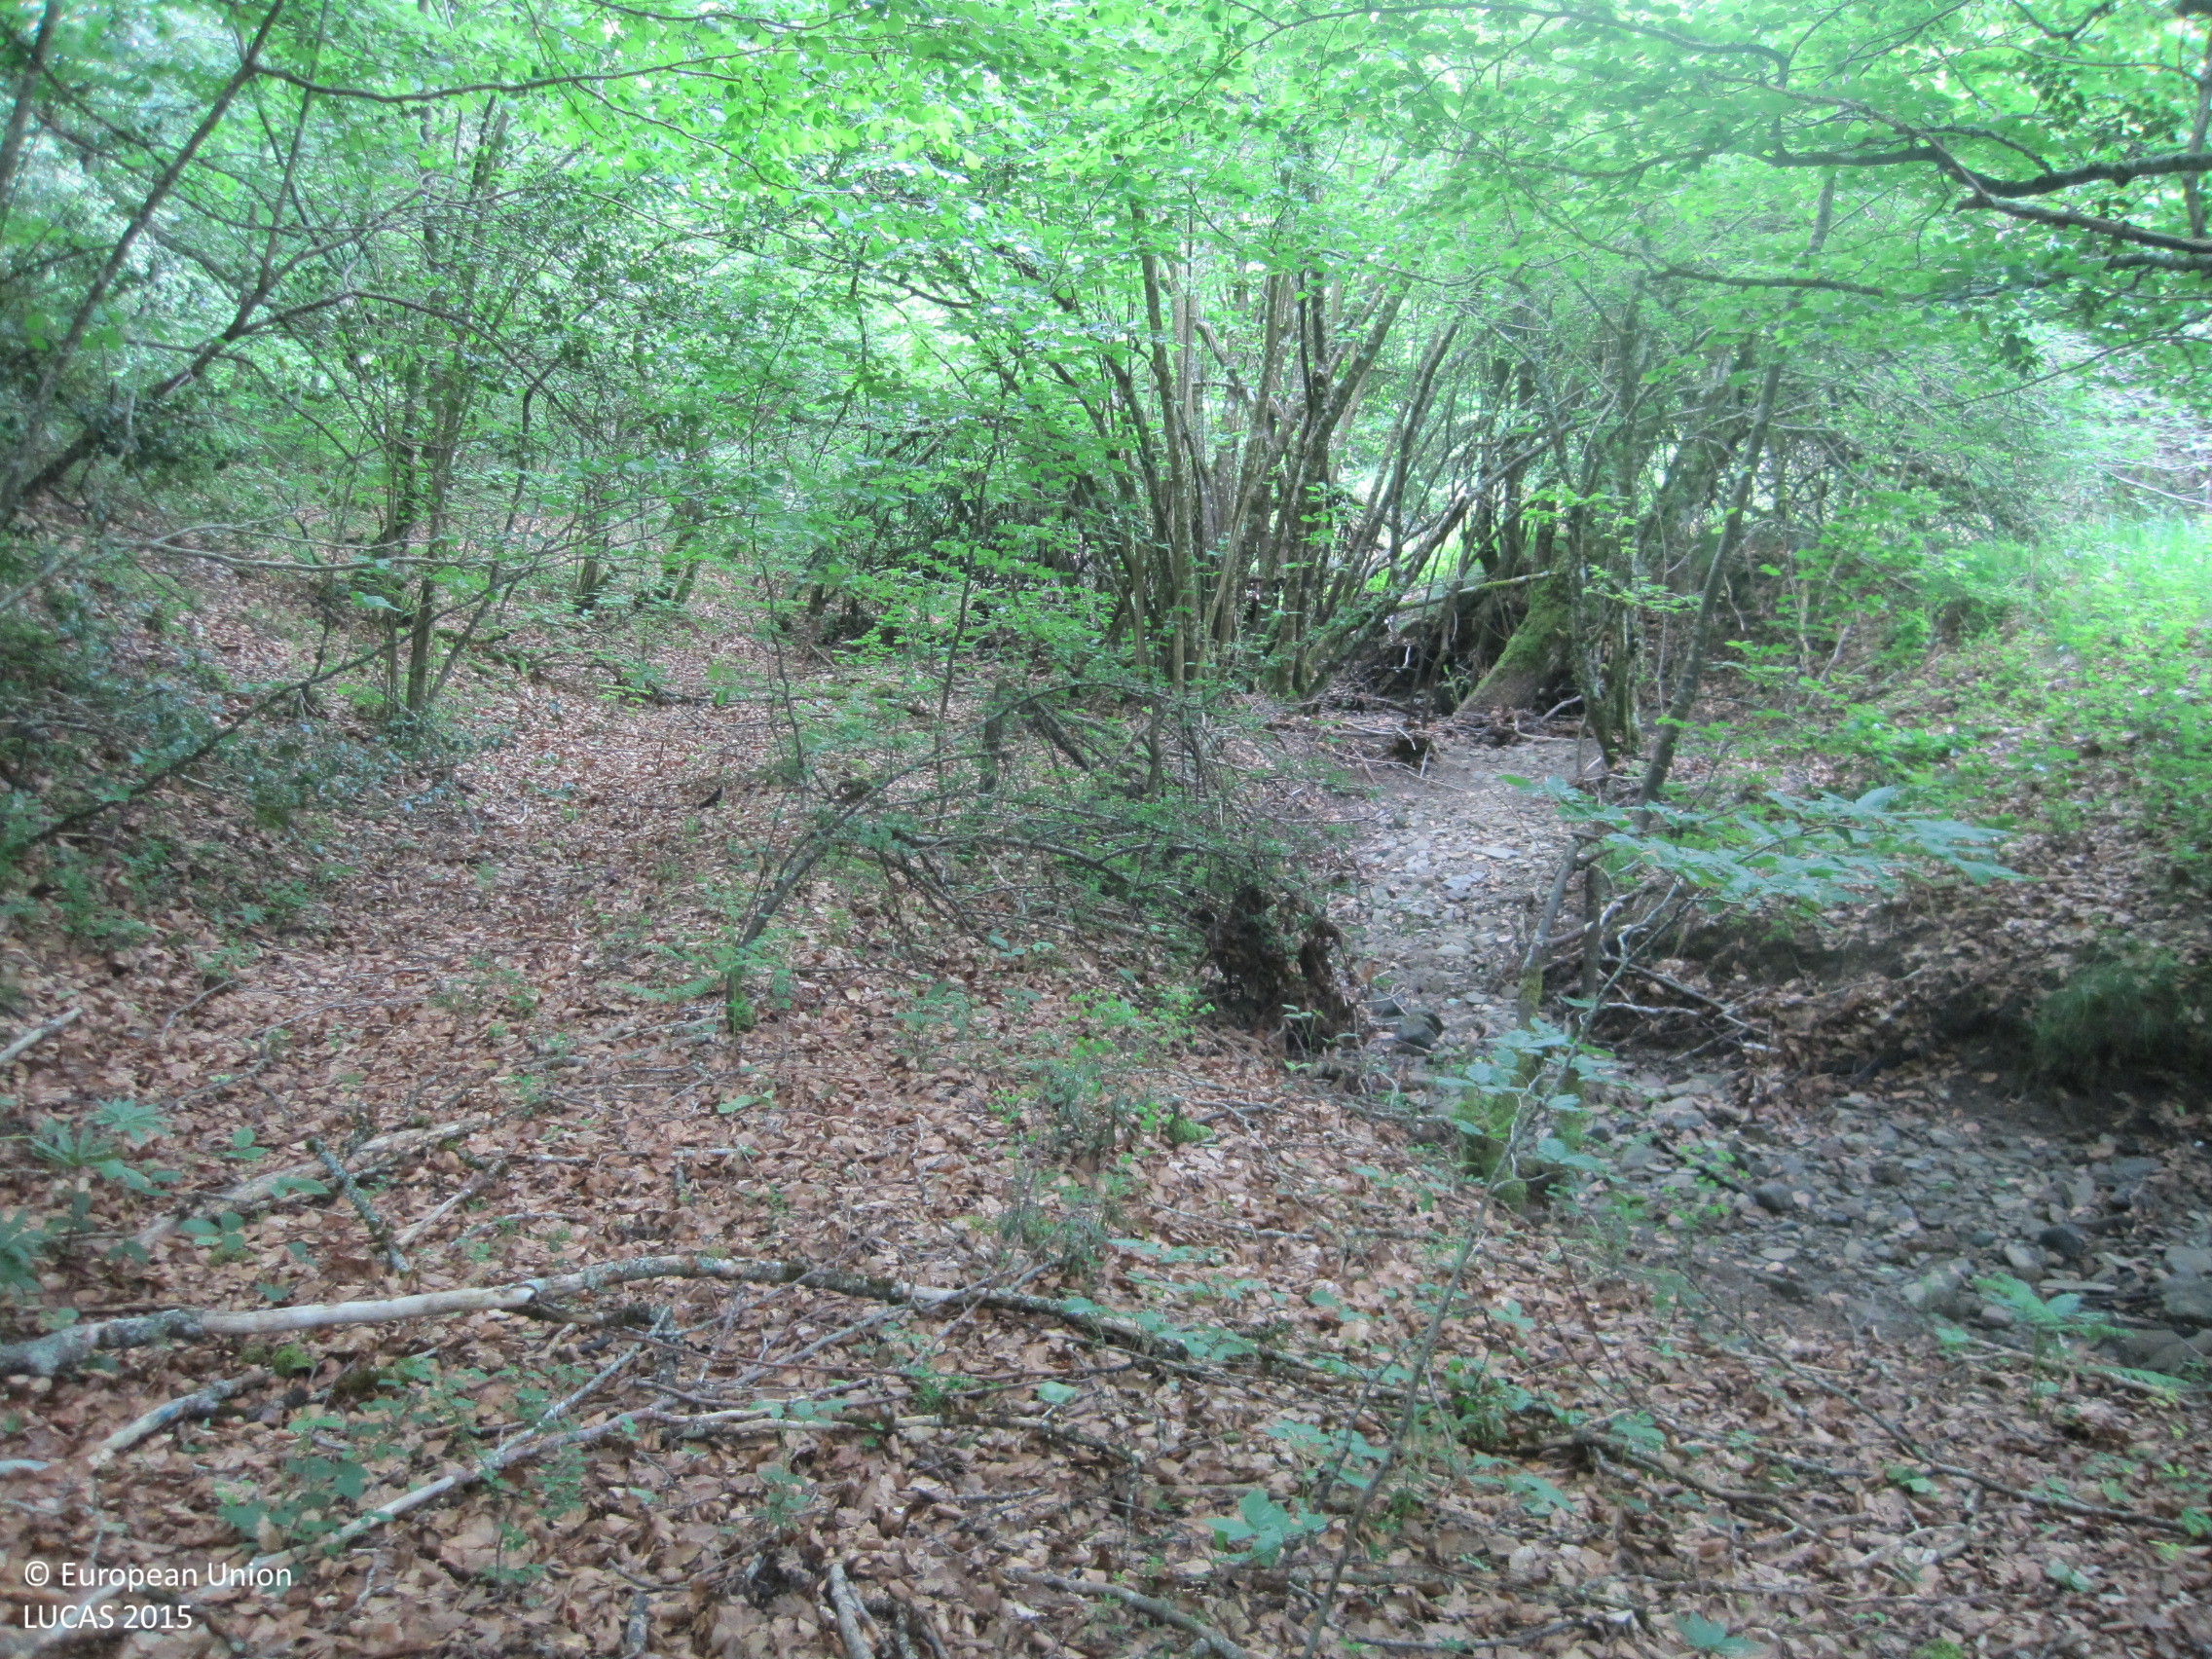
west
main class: Woodland
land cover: Broadleaved woodland
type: beech forest
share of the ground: > 75 %
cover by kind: broadleaved forest trees 100 %
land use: Forestry
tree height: > 5 m
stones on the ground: < 10 %
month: May
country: ES
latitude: 43.0019
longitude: -1.3108
